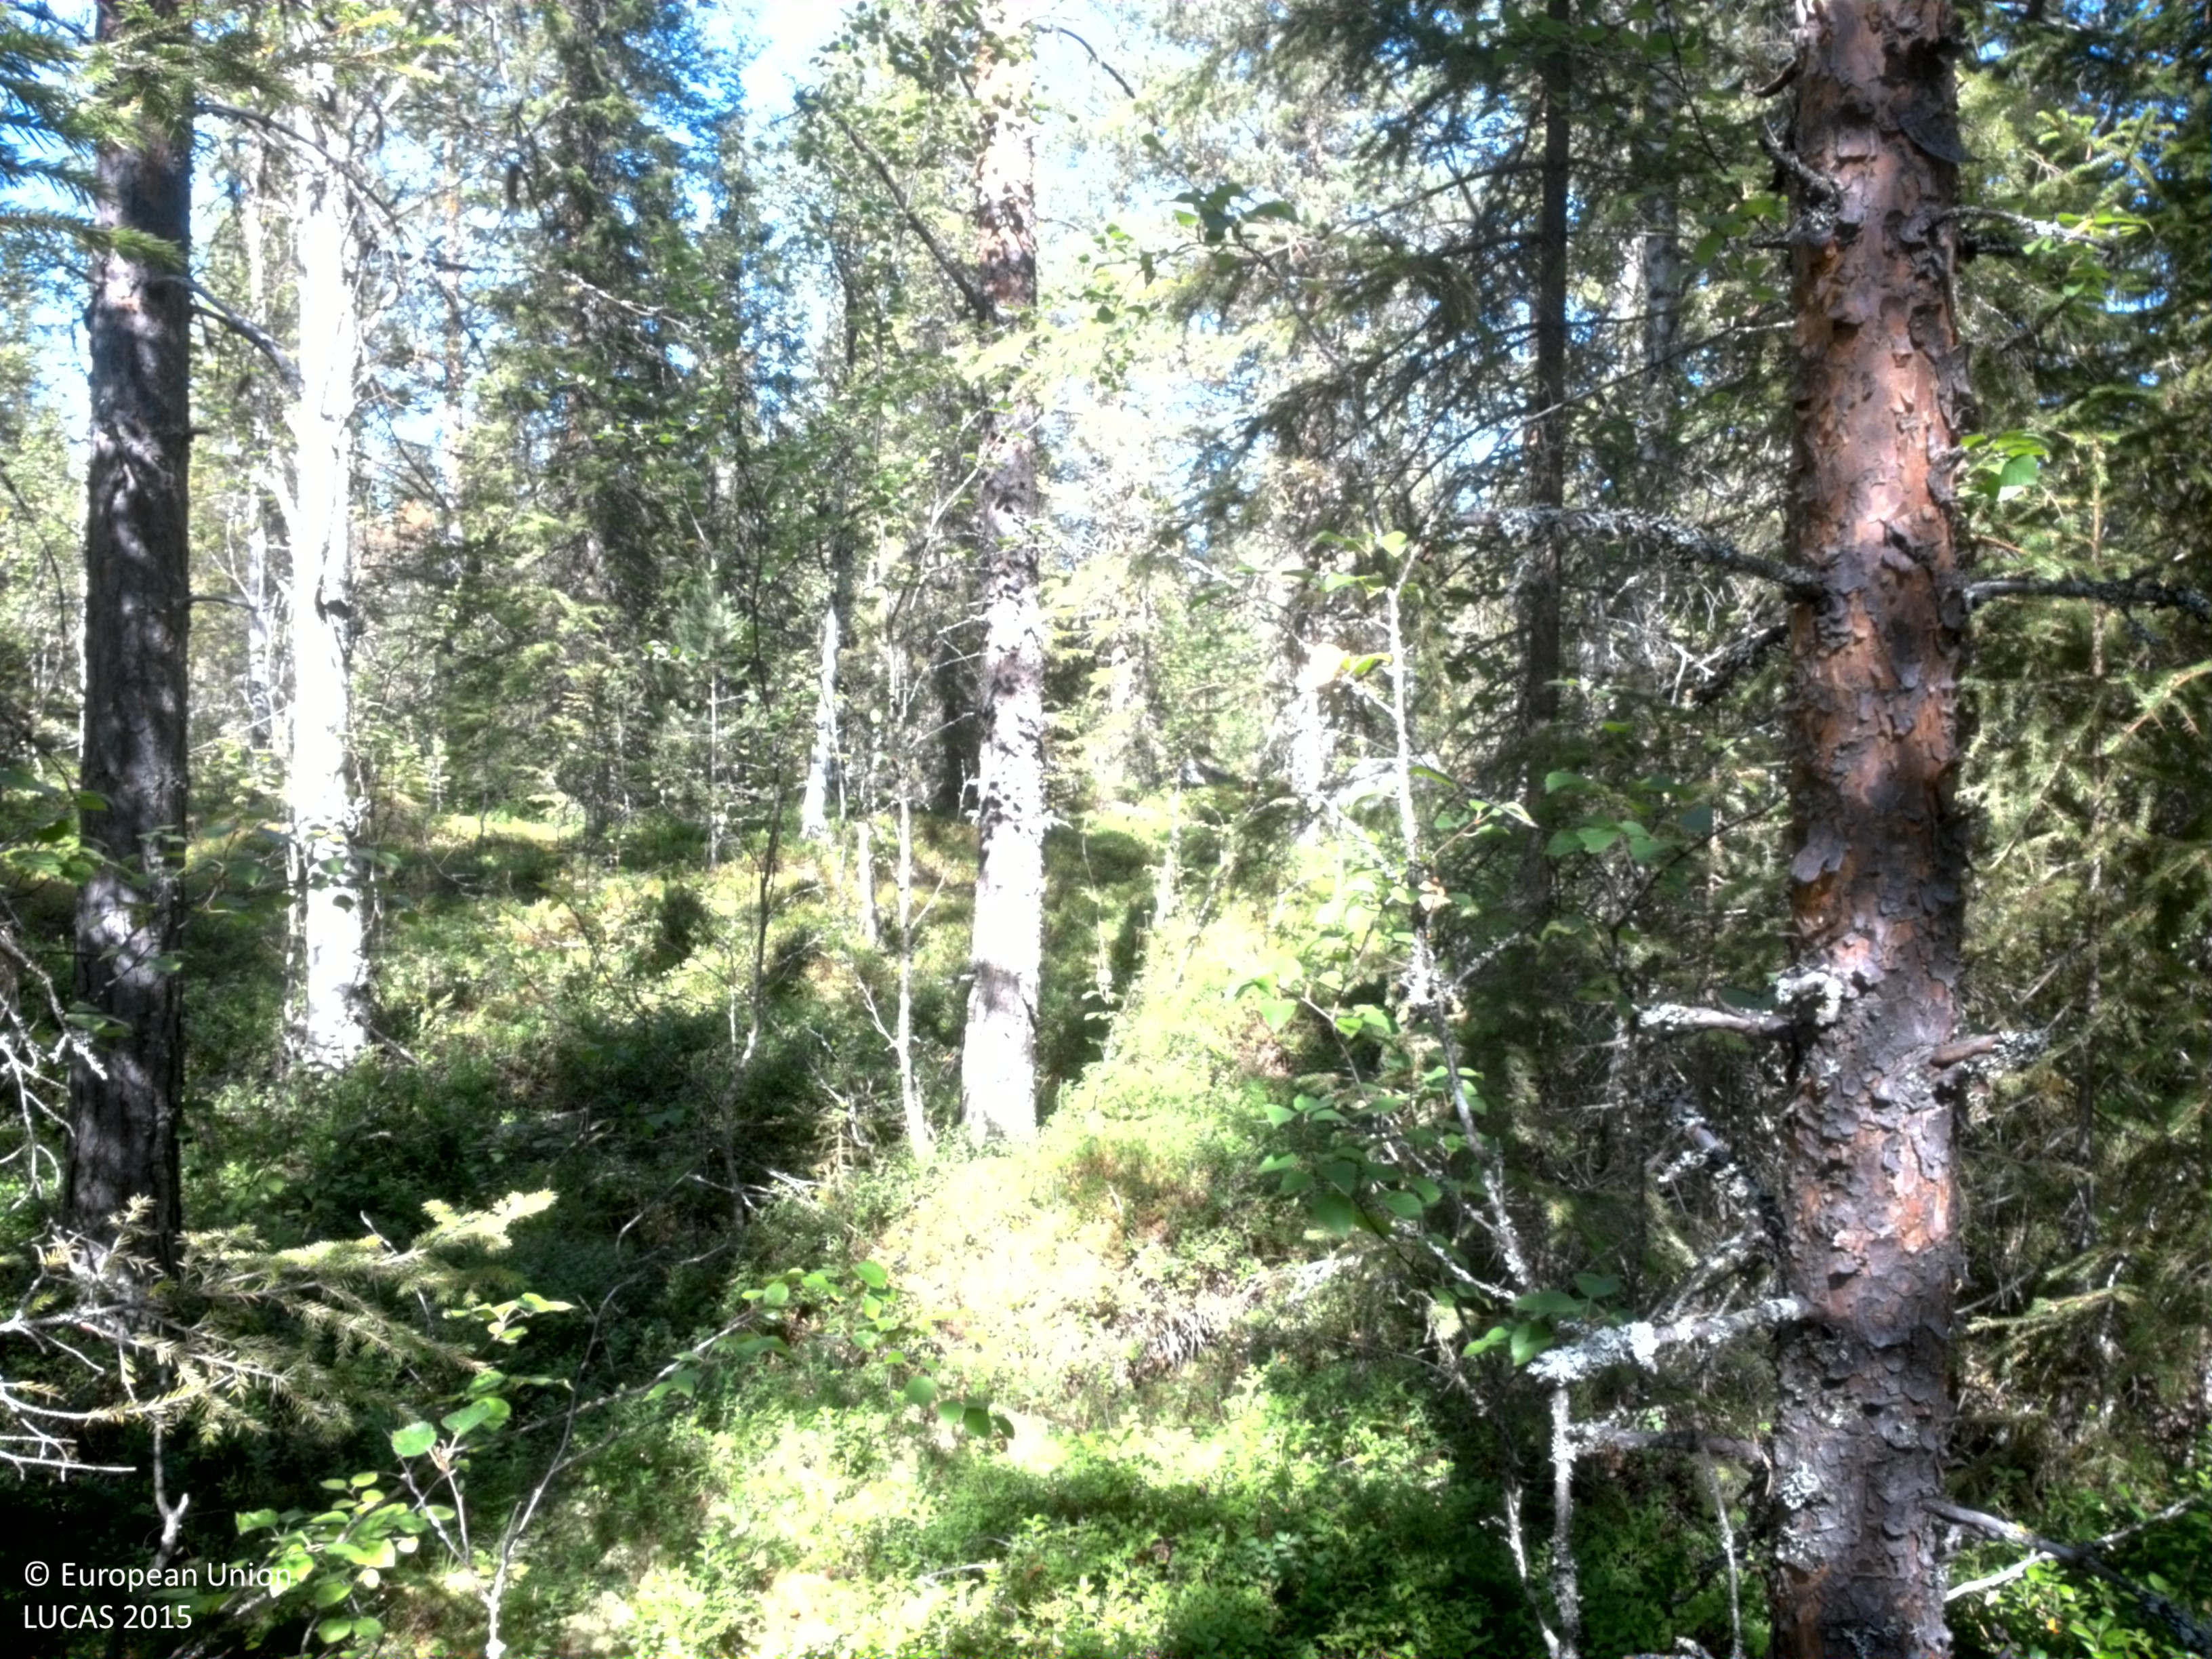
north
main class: Woodland
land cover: Pine dominated mixed woodland
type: boreal forest
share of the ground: 50 - 75 %
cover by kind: coniferous forest trees 45 %, shrubs 30 %, broadleaved forest trees 15 %, herbaceous plants 5 %, lichens and mosses 5 %
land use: Forestry
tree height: > 5 m
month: August
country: SE
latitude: 64.4847
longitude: 18.3951
